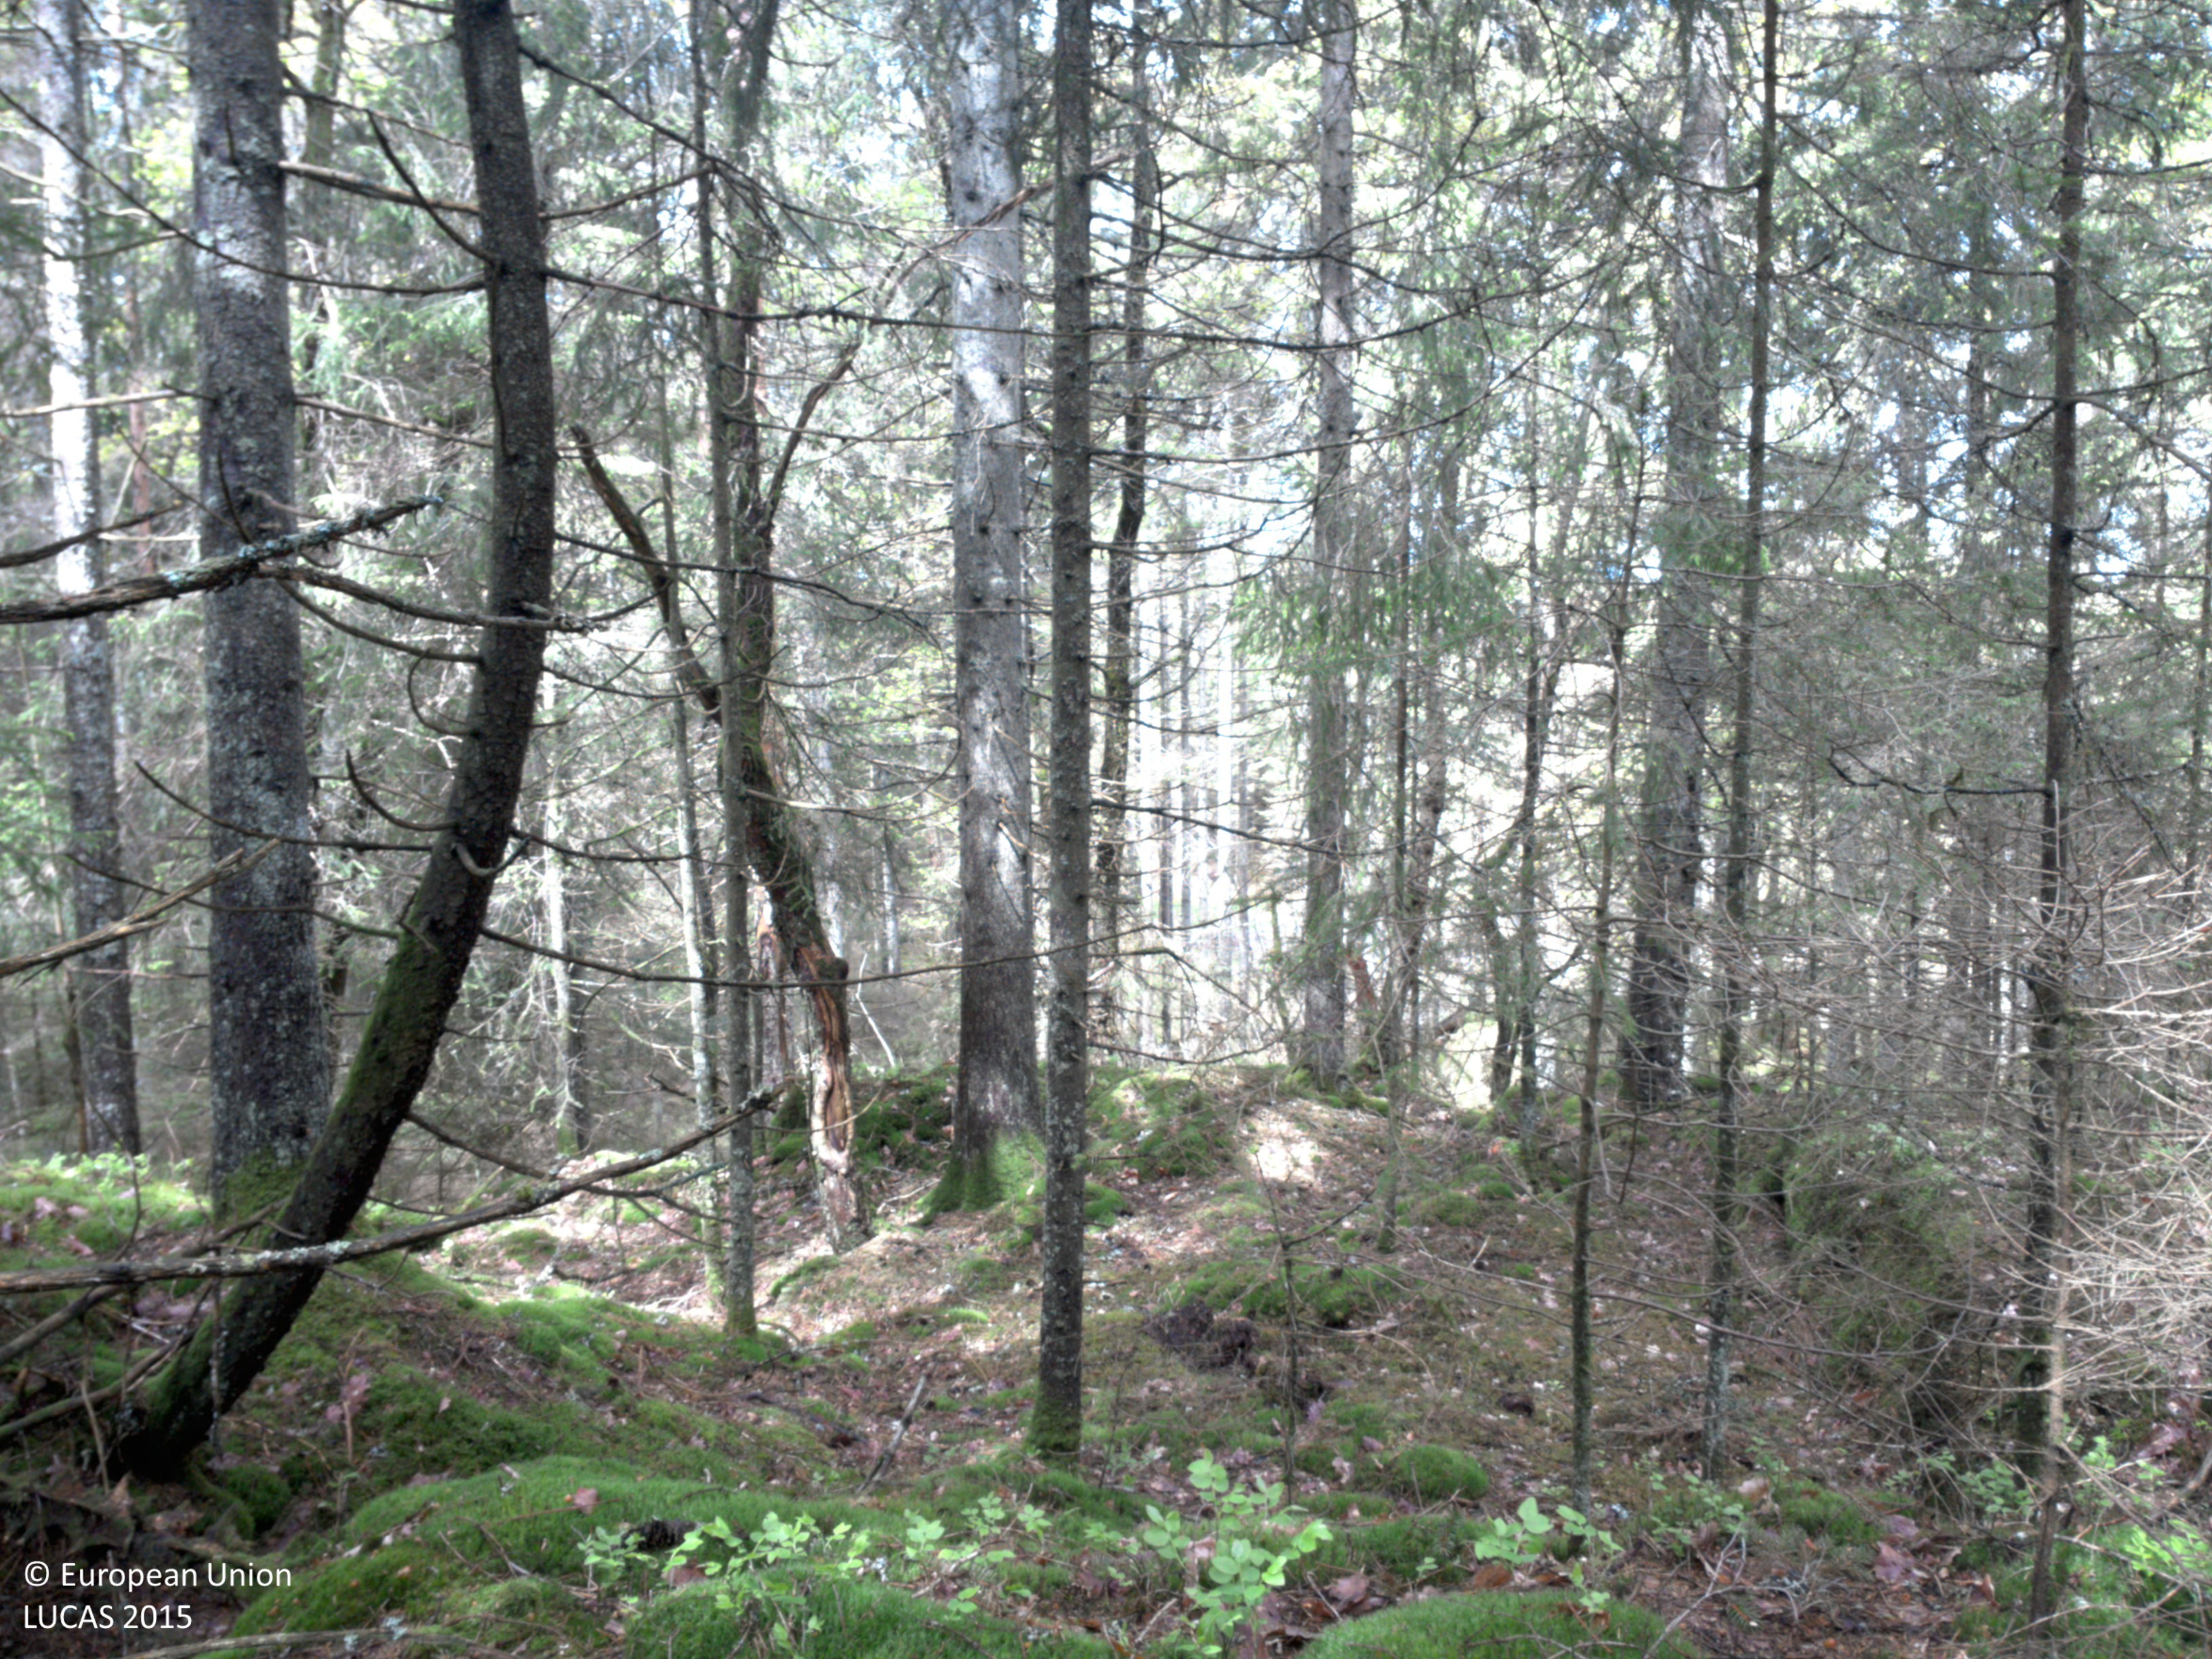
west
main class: Woodland
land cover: Spruce dominated coniferous woodland
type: boreal forest
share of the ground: 50 - 75 %
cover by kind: coniferous forest trees 65 %, herbaceous plants 35 %
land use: Forestry
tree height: > 5 m
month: June
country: SE
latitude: 57.9711
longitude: 11.9744
